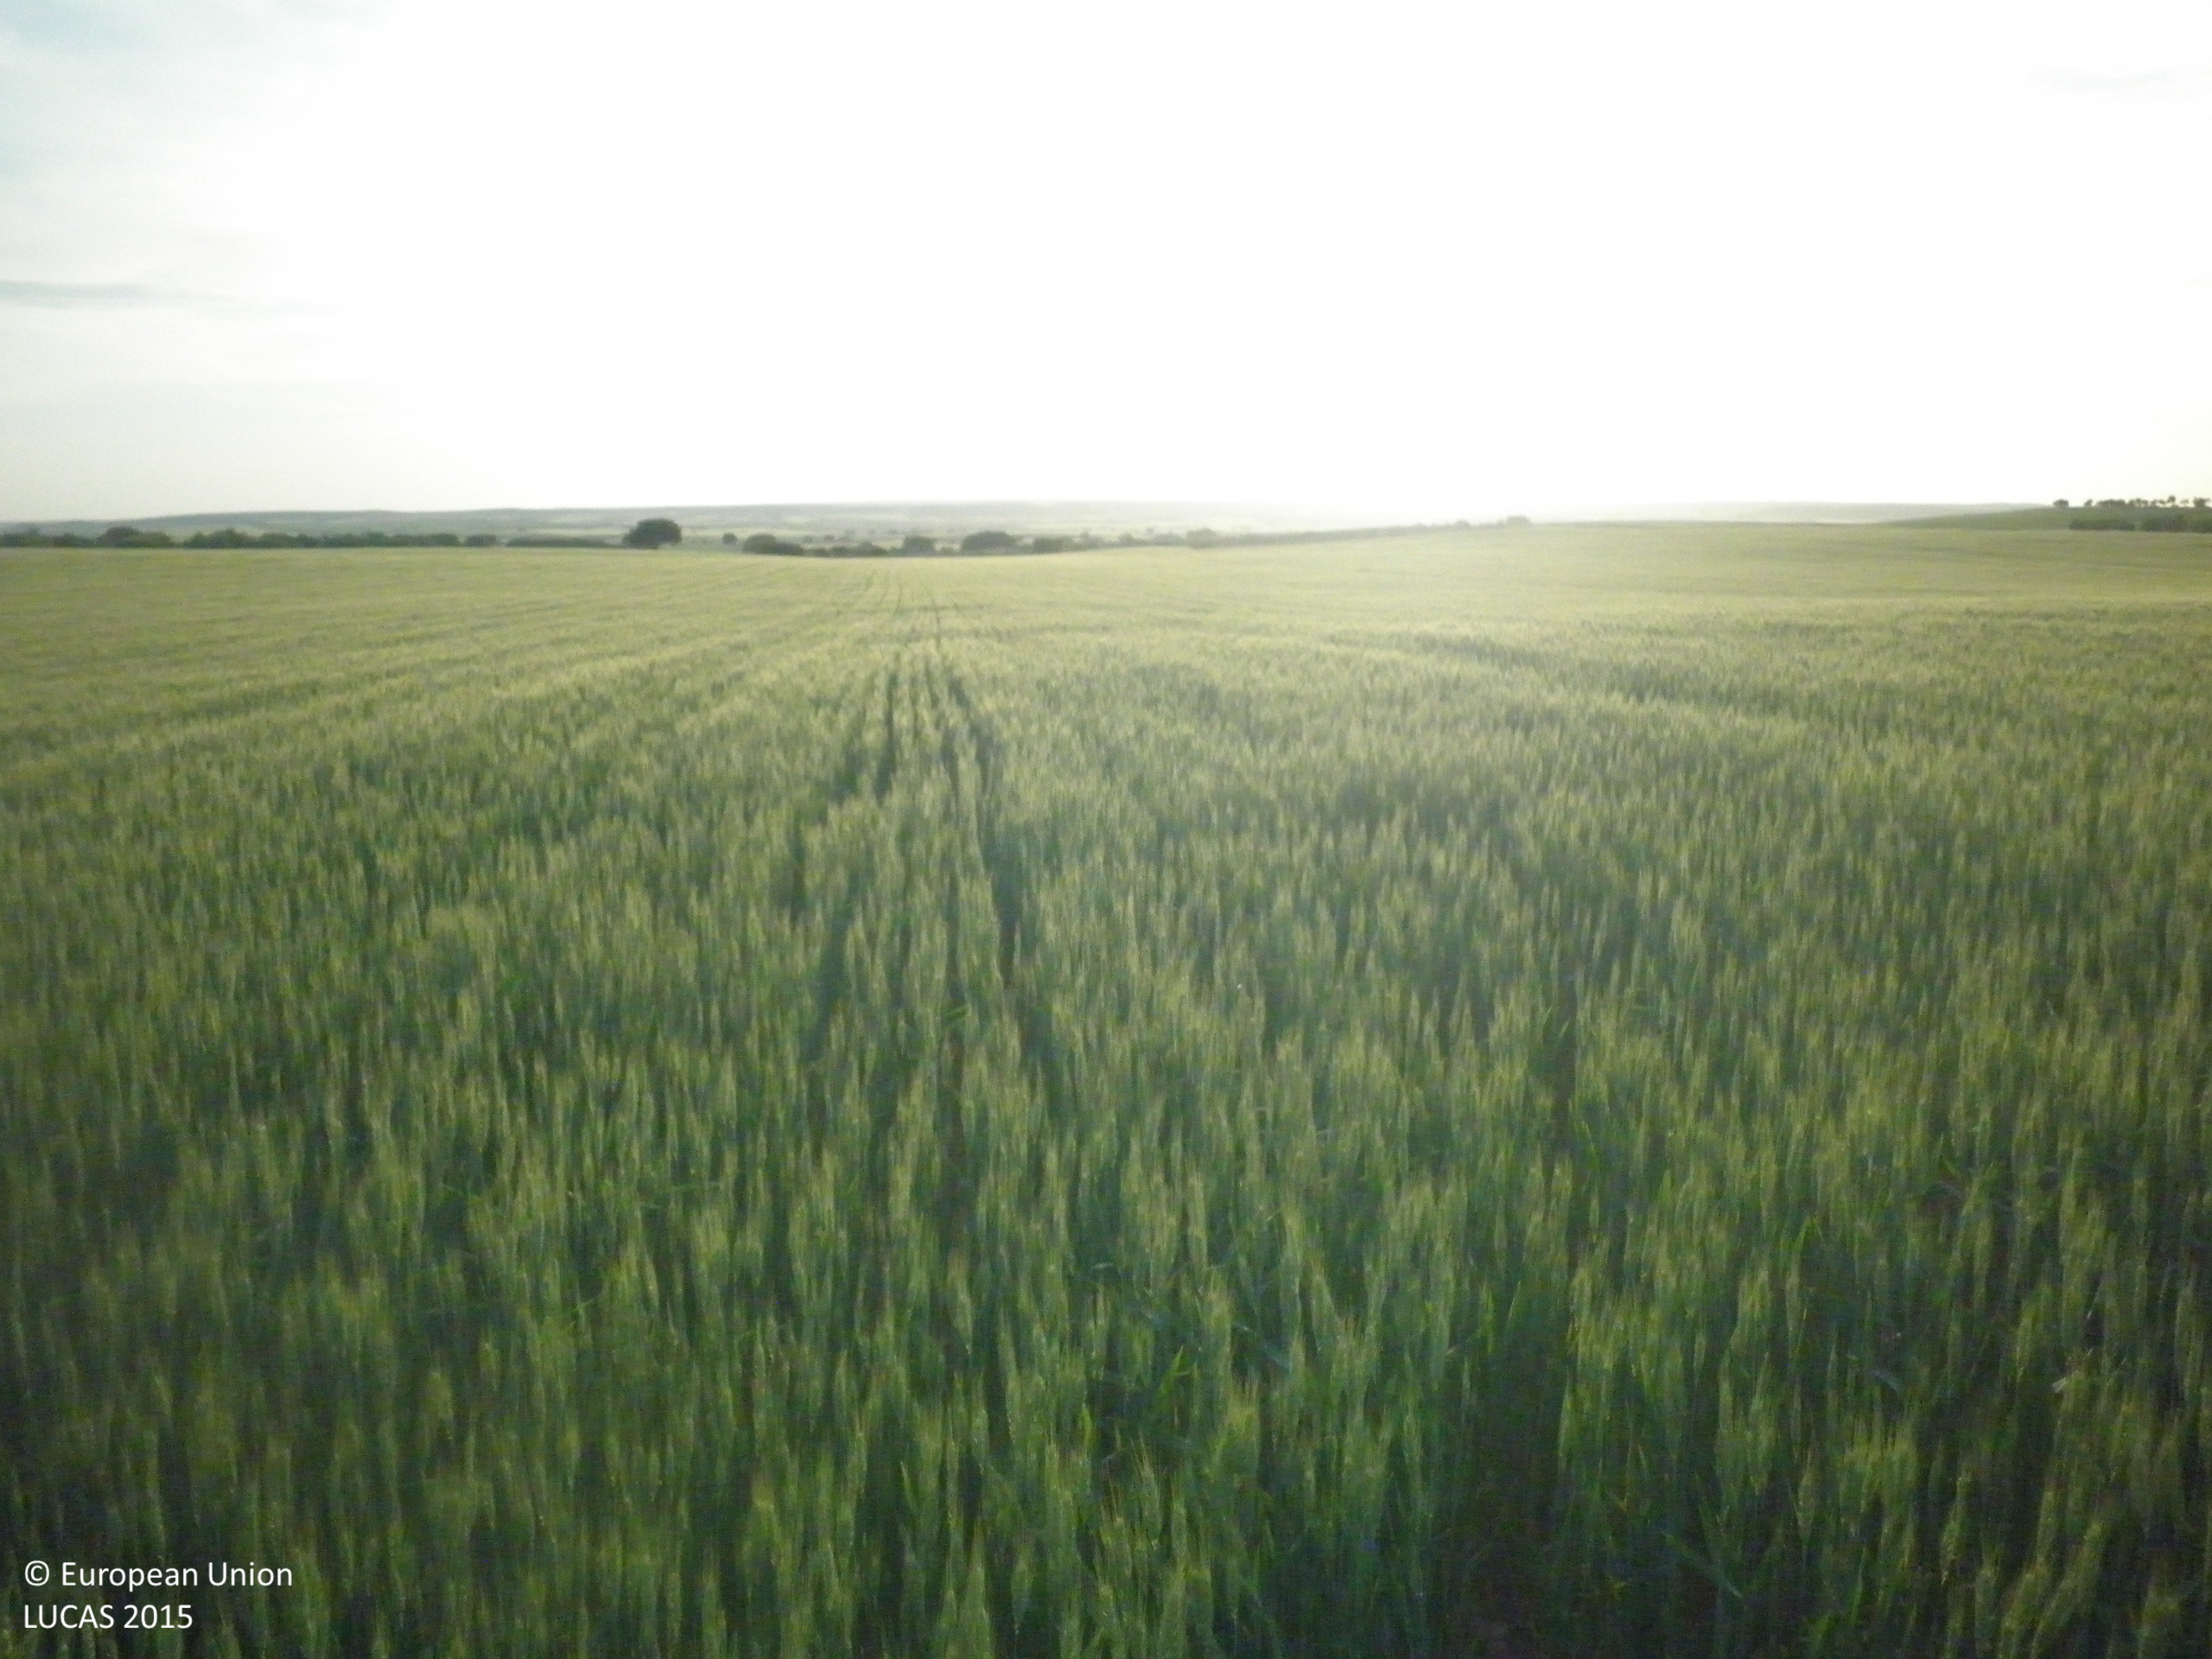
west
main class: Cropland
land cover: Durum wheat
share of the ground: > 75 %
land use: Agriculture (excluding fallow land and kitchen gardens)
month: May
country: ES
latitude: 39.6033
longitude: -2.6980
